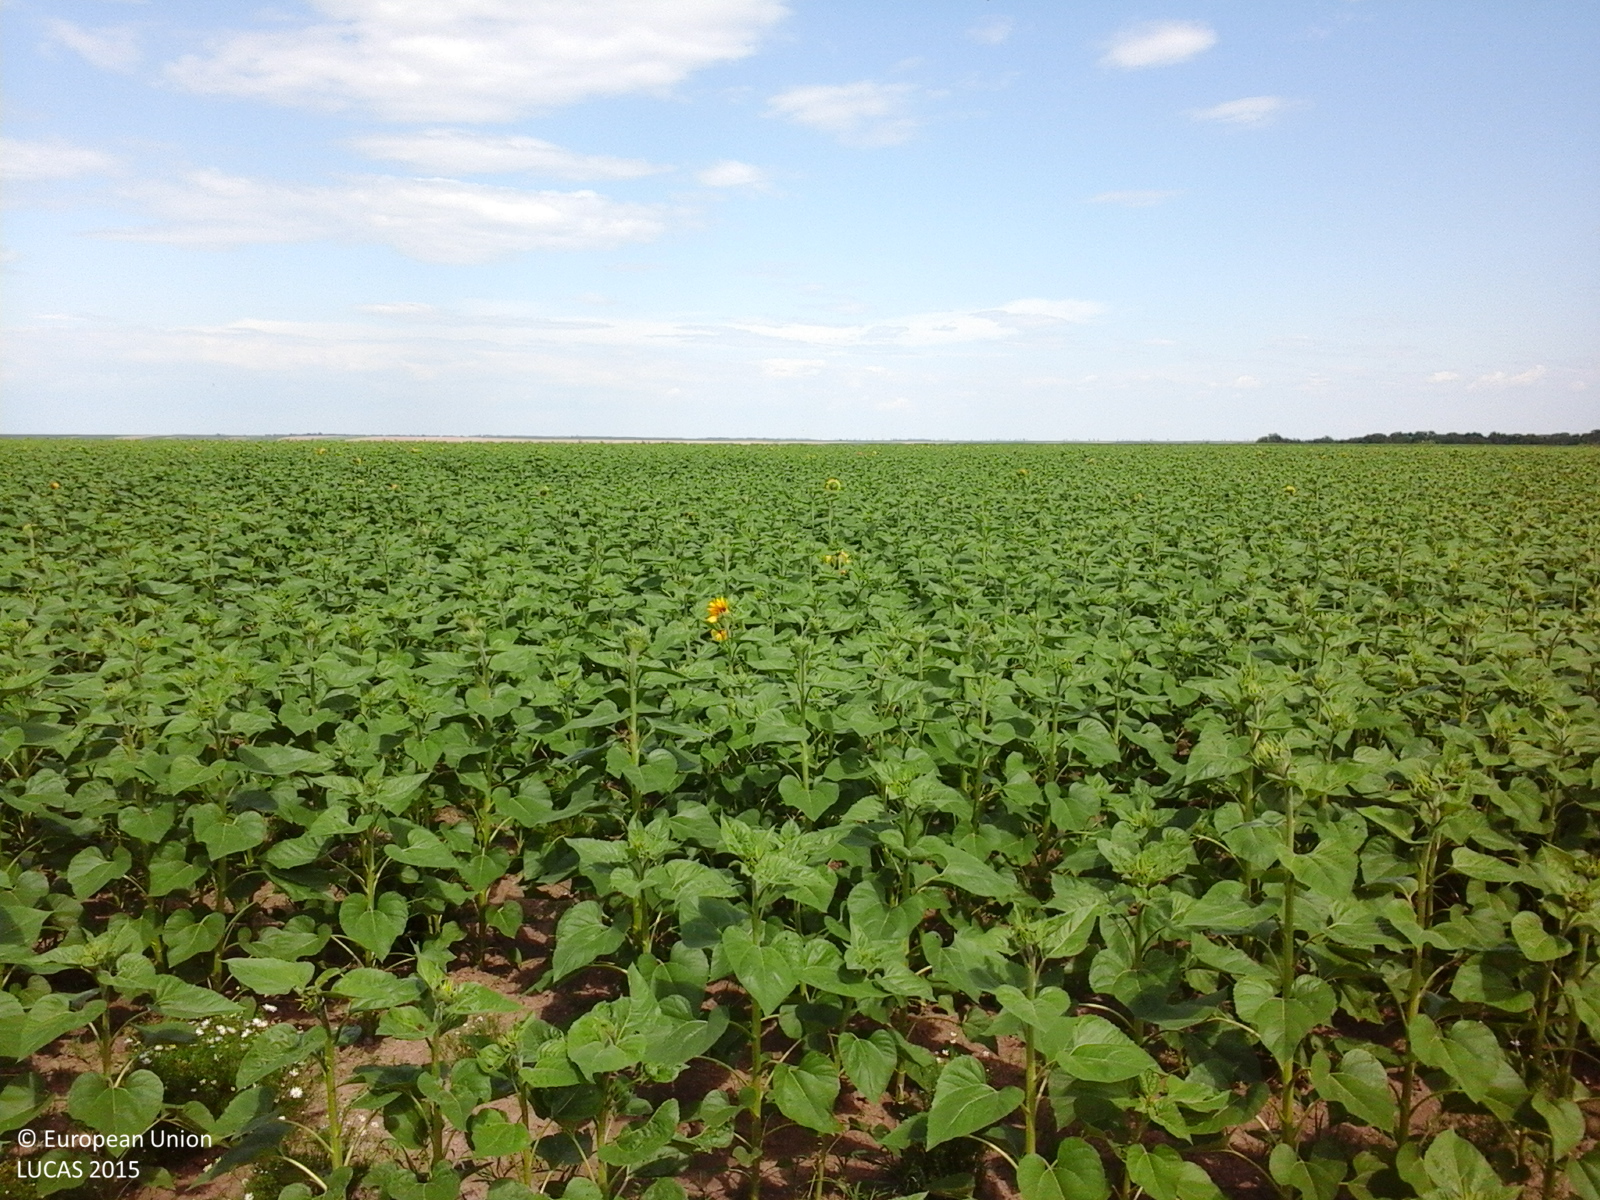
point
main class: Cropland
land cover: Sunflower
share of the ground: > 75 %
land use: Agriculture (excluding fallow land and kitchen gardens)
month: July
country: RO
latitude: 44.3319
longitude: 24.7601
